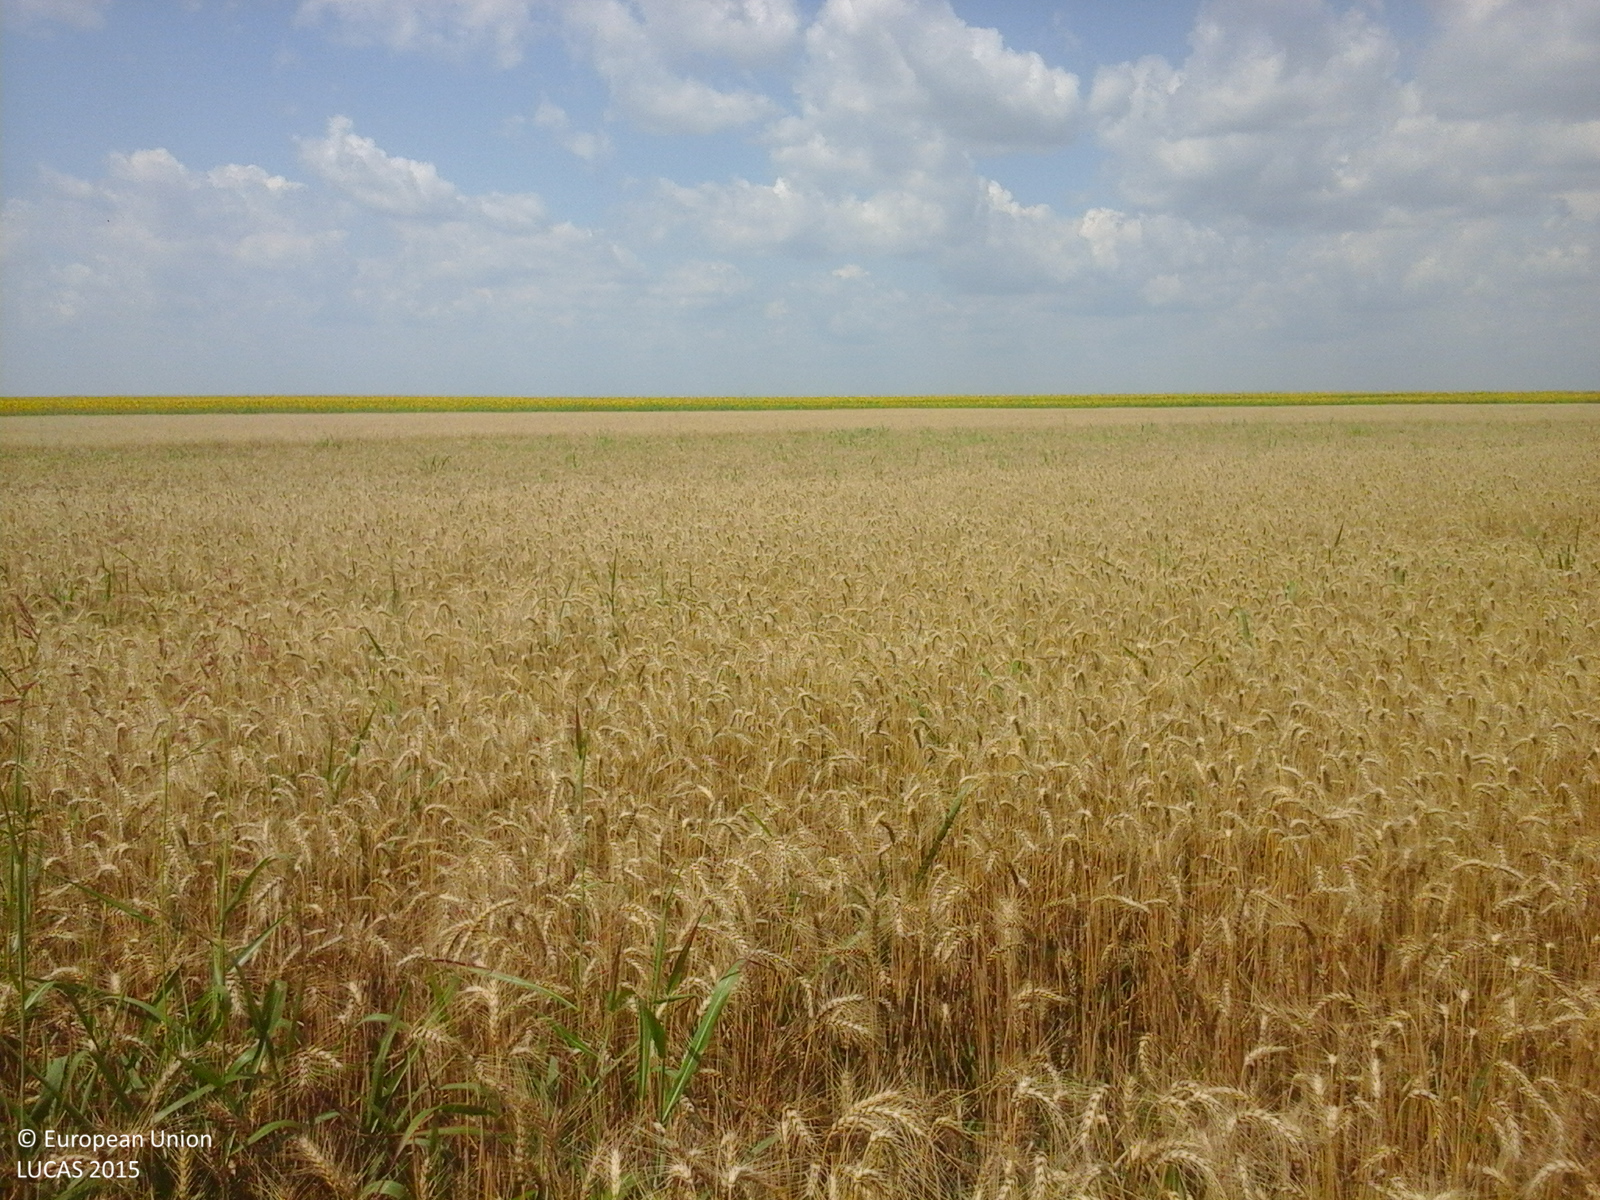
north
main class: Cropland
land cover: Common wheat
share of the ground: > 75 %
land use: Agriculture (excluding fallow land and kitchen gardens)
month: July
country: RO
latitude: 44.0388
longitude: 24.5052
